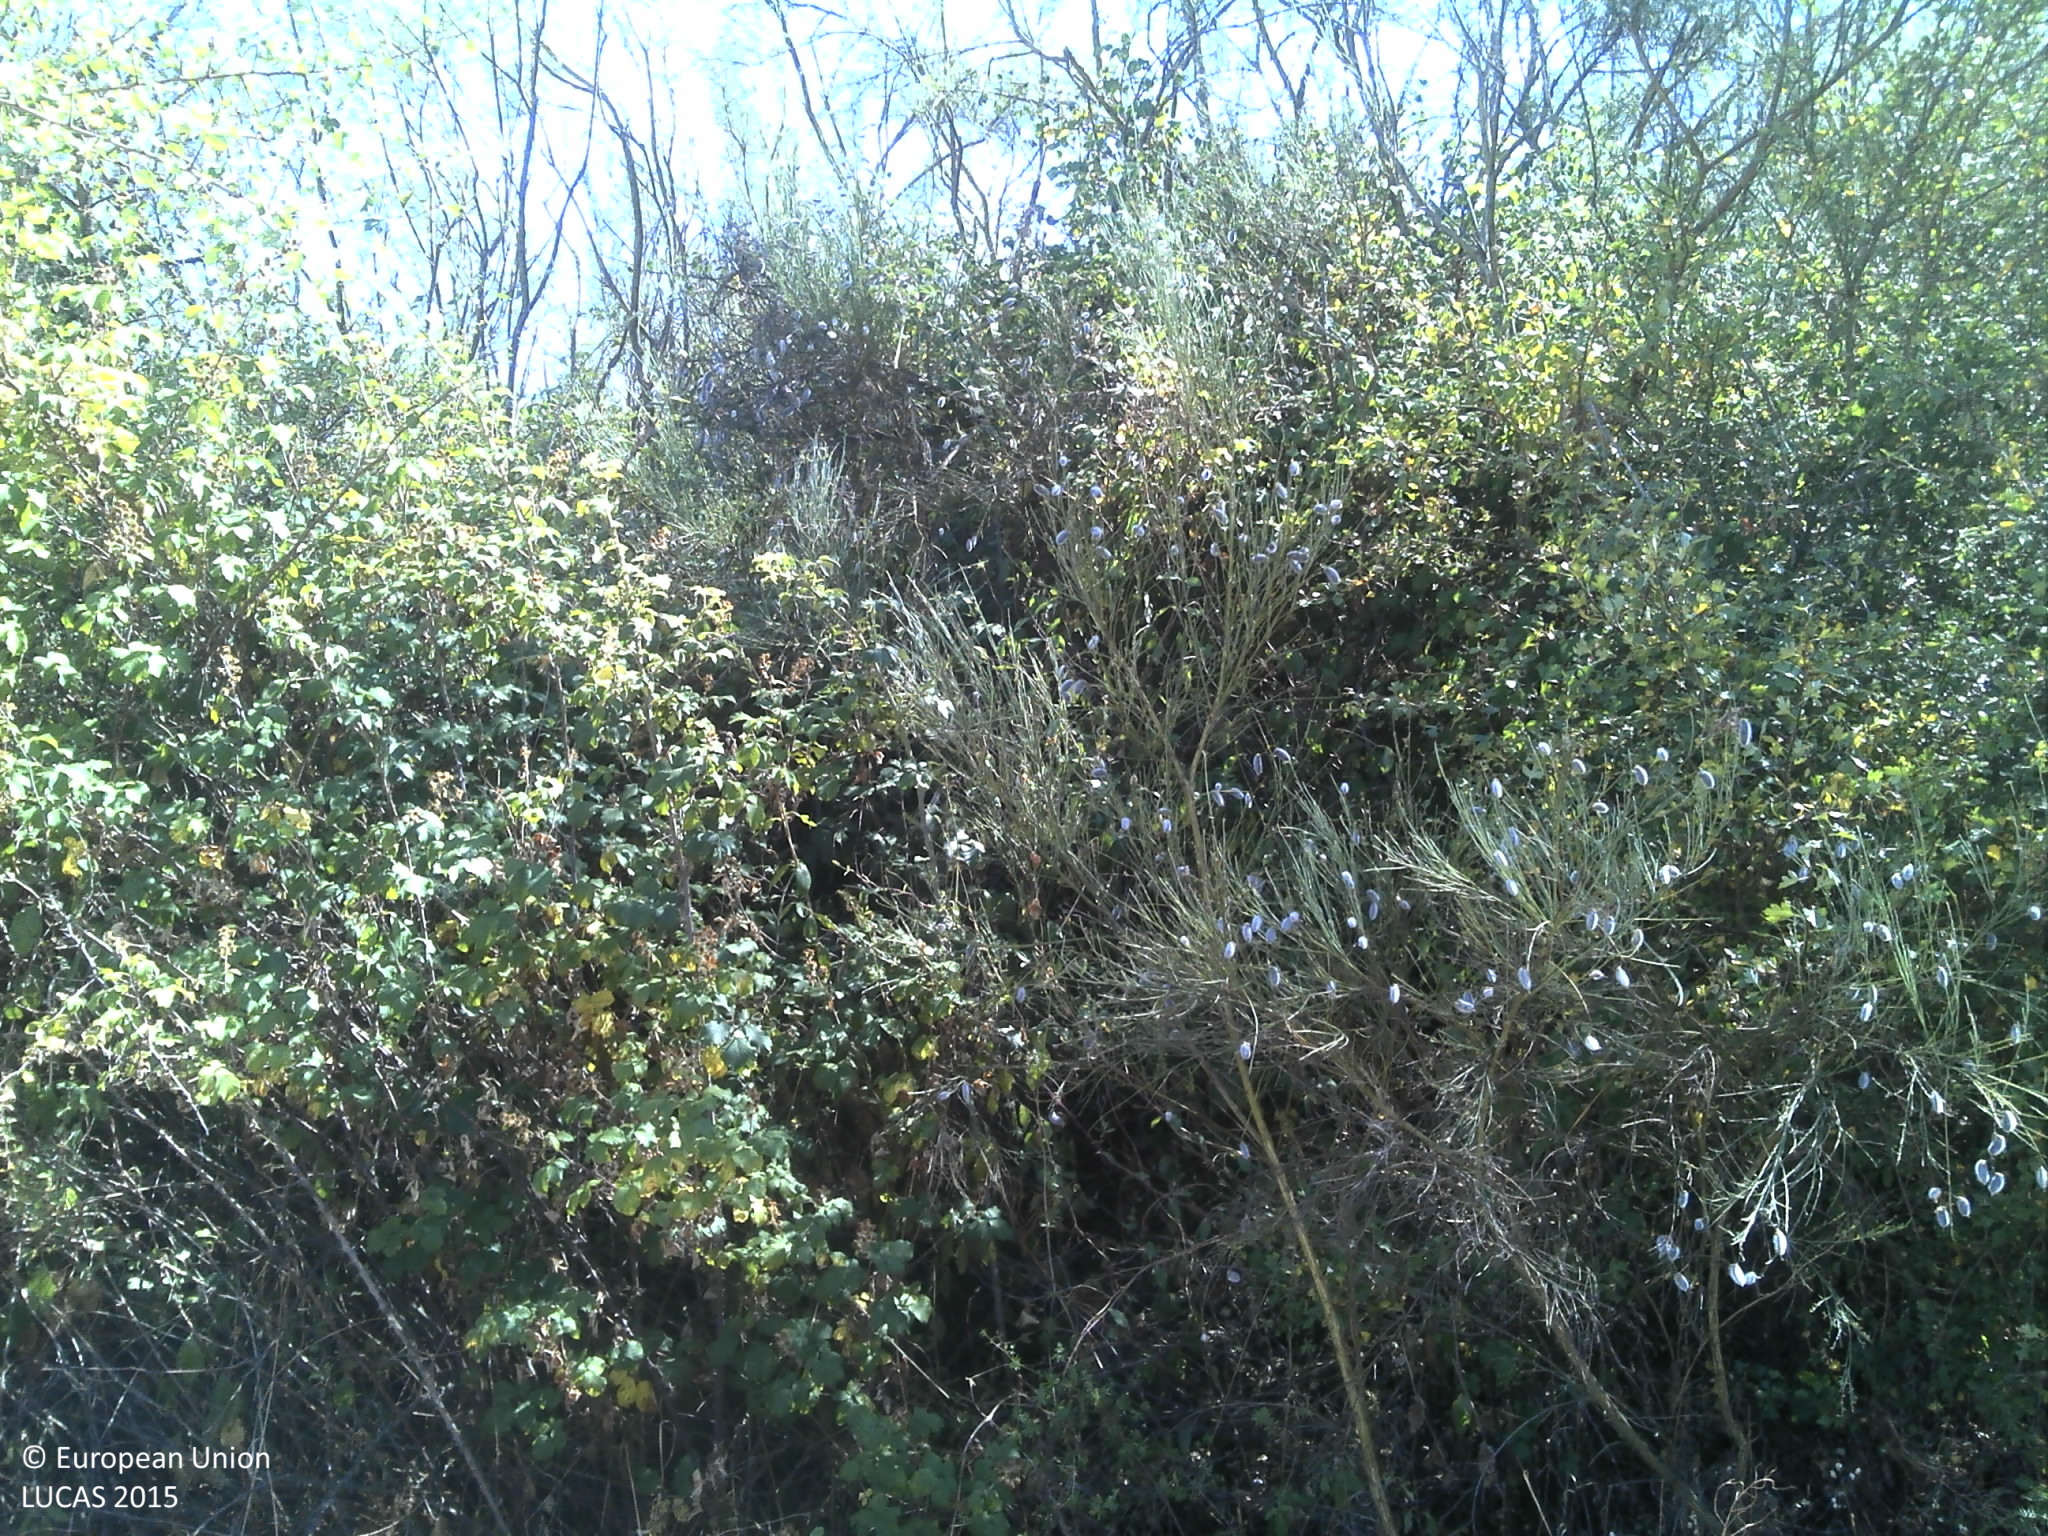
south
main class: Shrubland
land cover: Shrubland without tree cover
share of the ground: > 75 %
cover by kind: shrubs 85 %, herbaceous plants 5 %, unconsolidated bare surface 5 %
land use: Abandoned areas
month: July
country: PT
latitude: 40.1863
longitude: -7.6449
